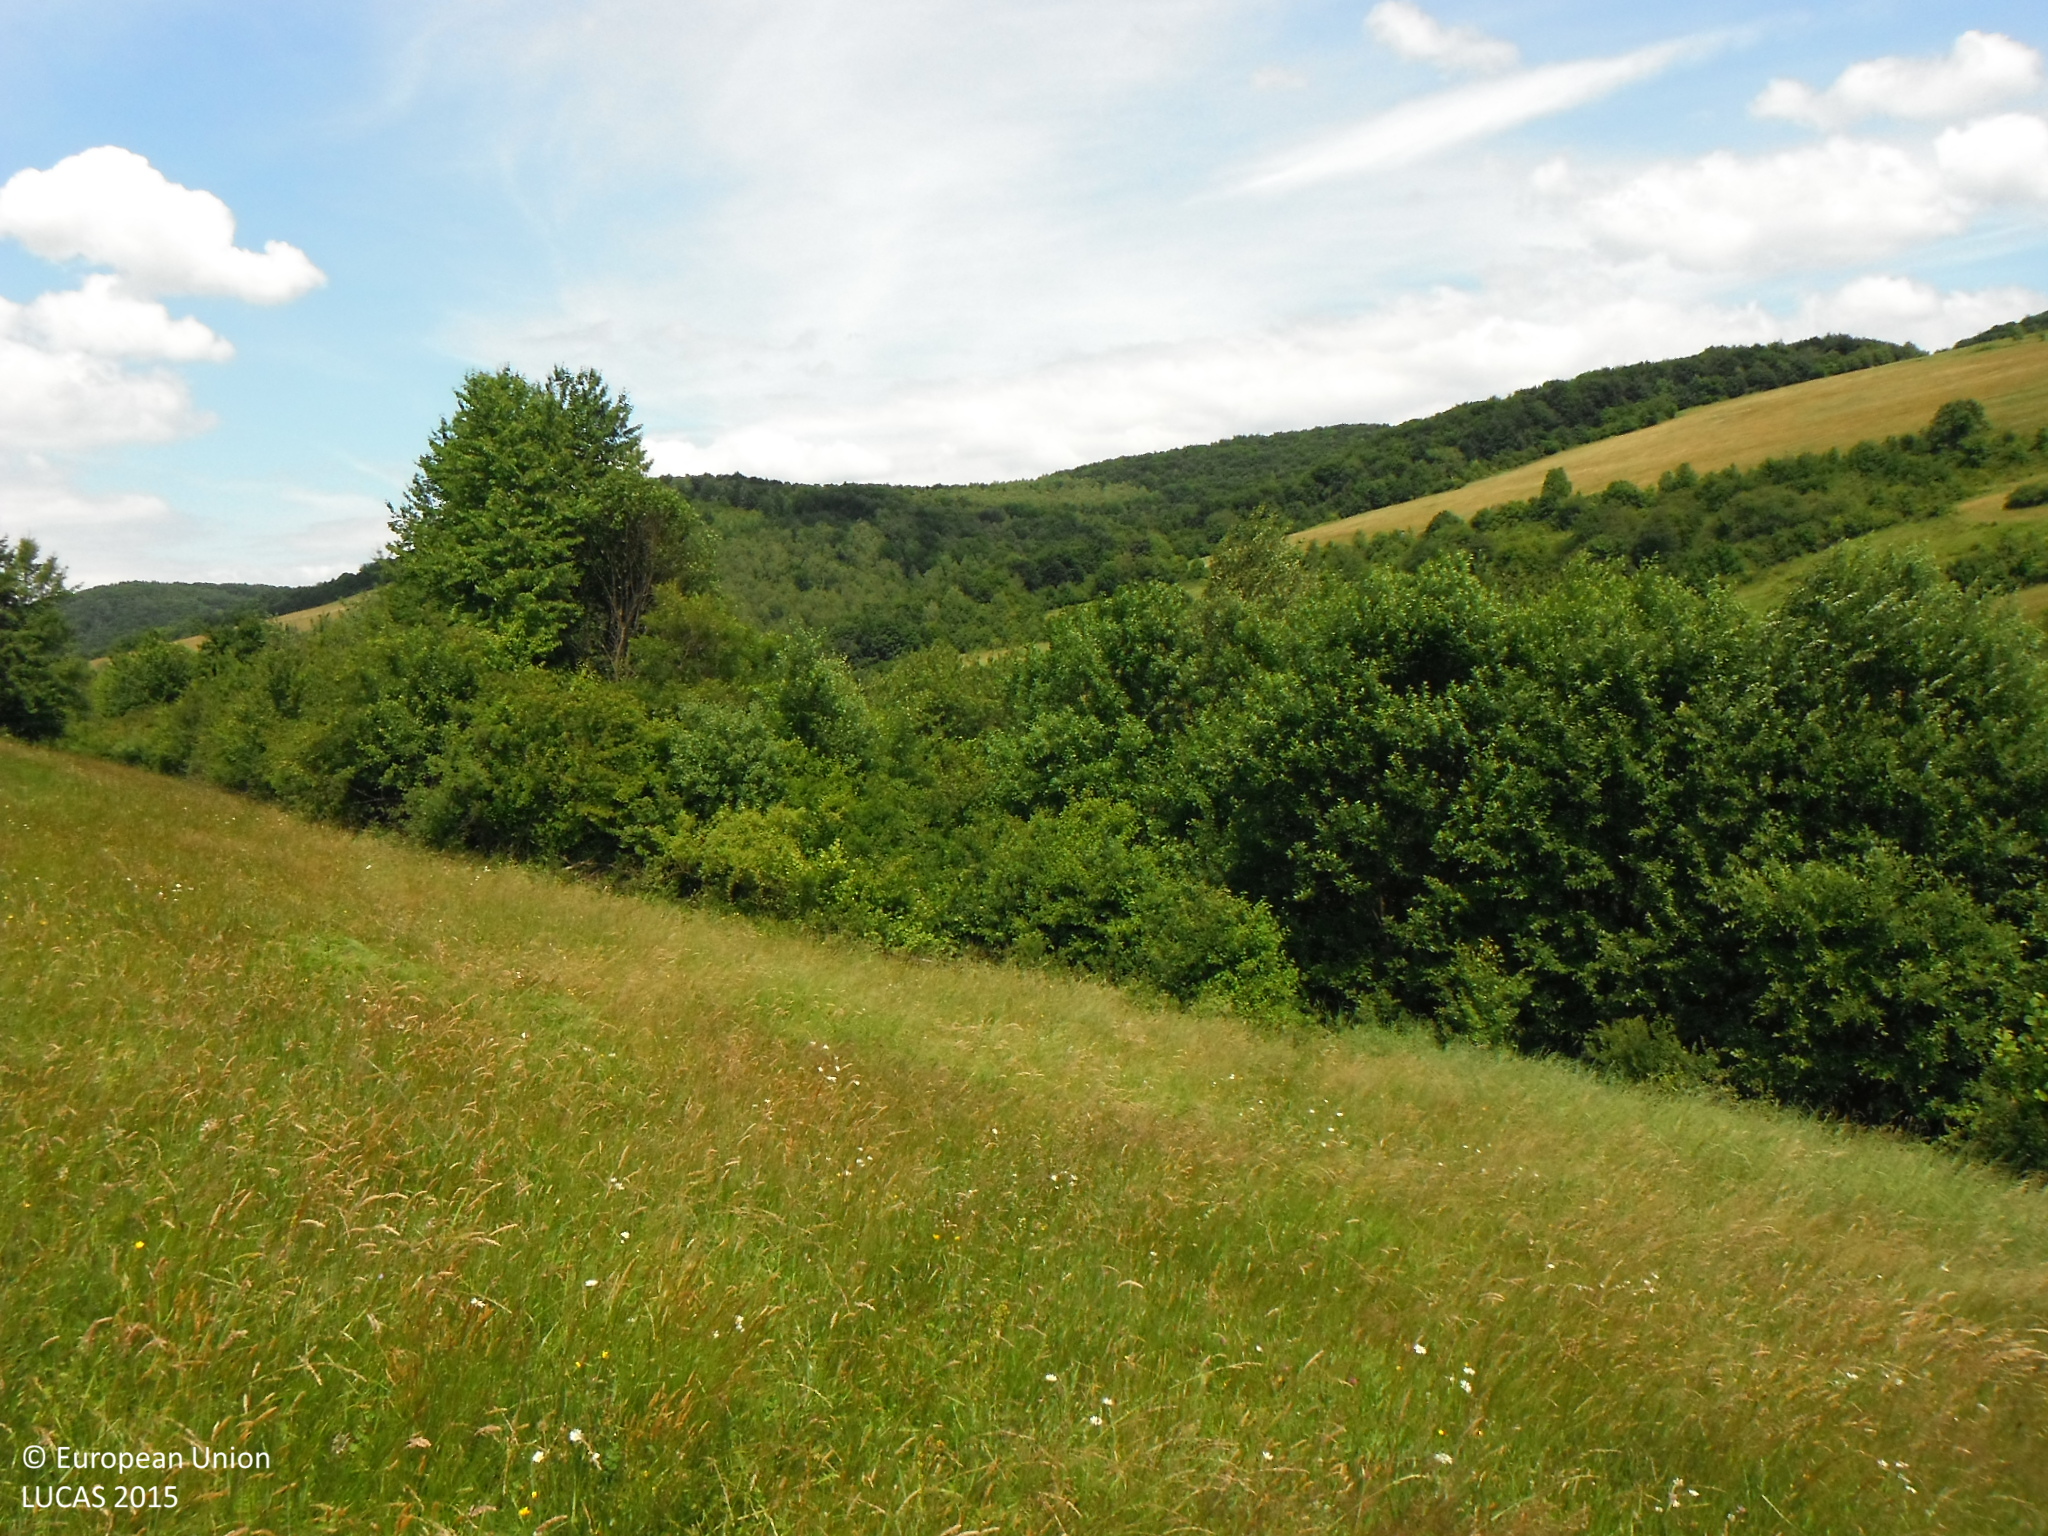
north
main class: Grassland
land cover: Grassland without tree/shrub cover
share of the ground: > 75 %
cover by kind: herbaceous plants 100 %
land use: Agriculture (excluding fallow land and kitchen gardens)
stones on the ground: < 10 %
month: June
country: SK
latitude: 49.1563
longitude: 21.7485
